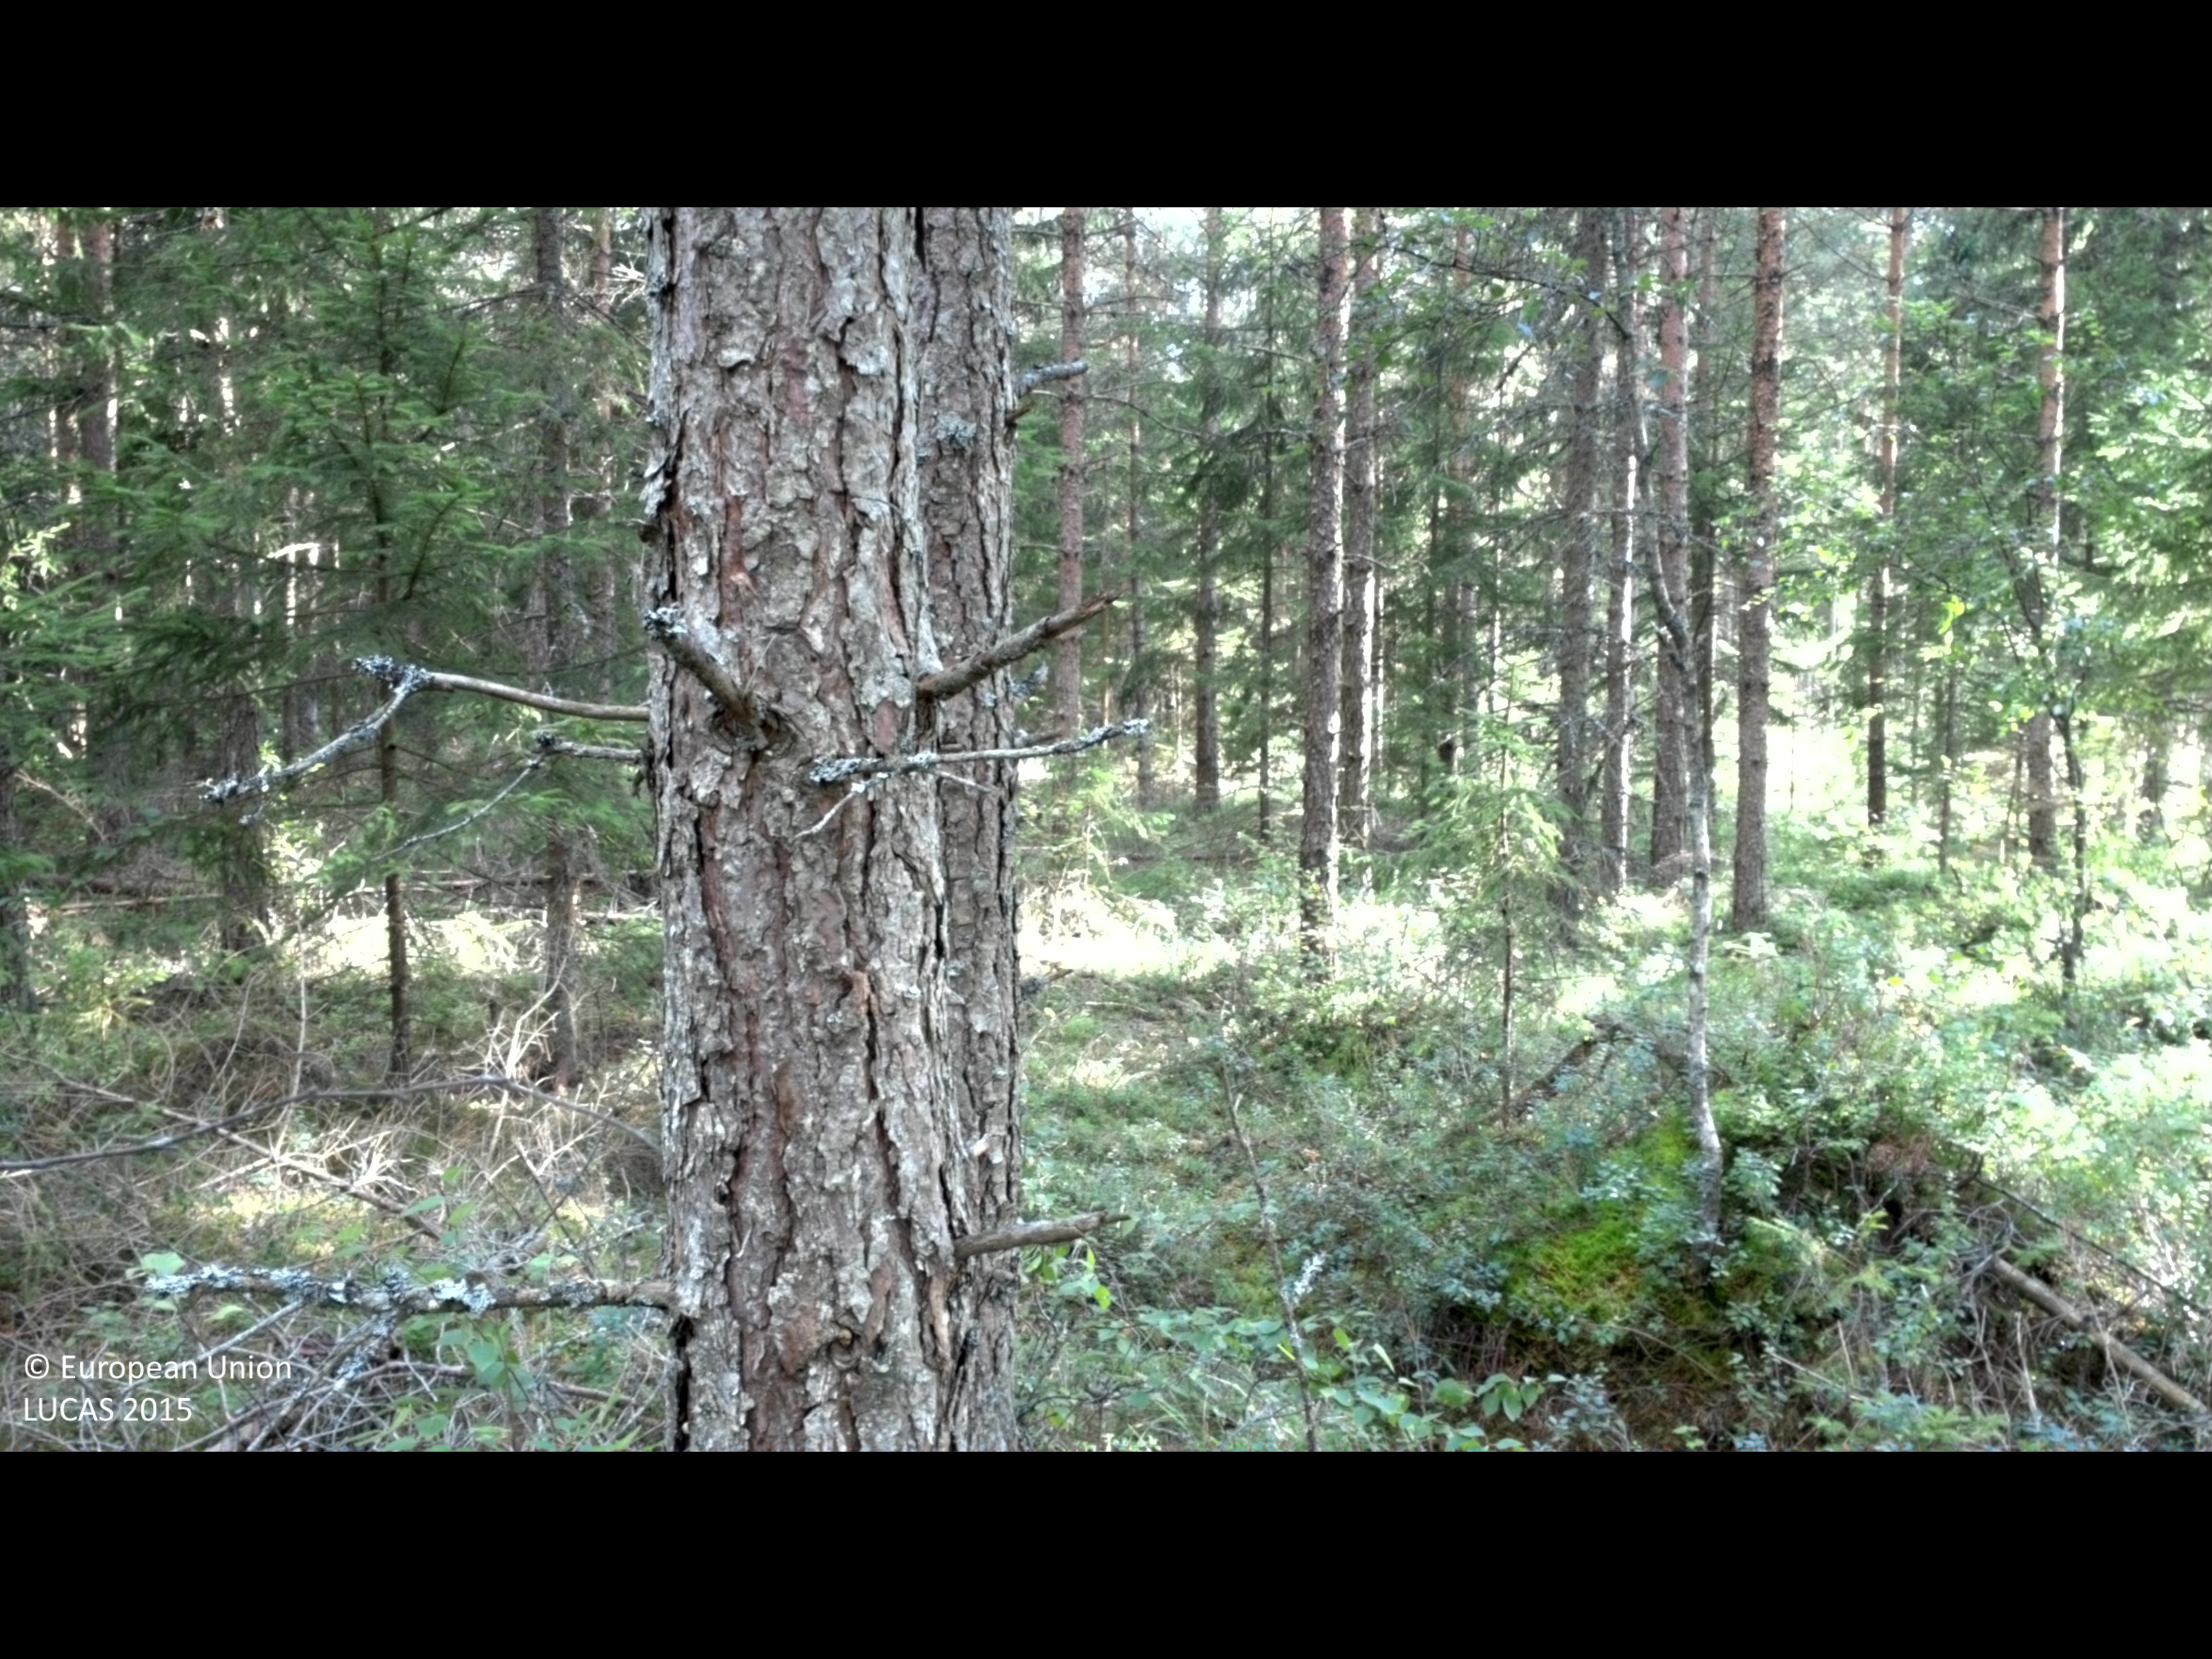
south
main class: Woodland
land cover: Pine dominated coniferous woodland
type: boreal forest
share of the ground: > 75 %
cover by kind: coniferous forest trees 75 %, shrubs 25 %
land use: Forestry
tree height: > 5 m
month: August
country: SE
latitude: 57.2270
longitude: 13.8884
